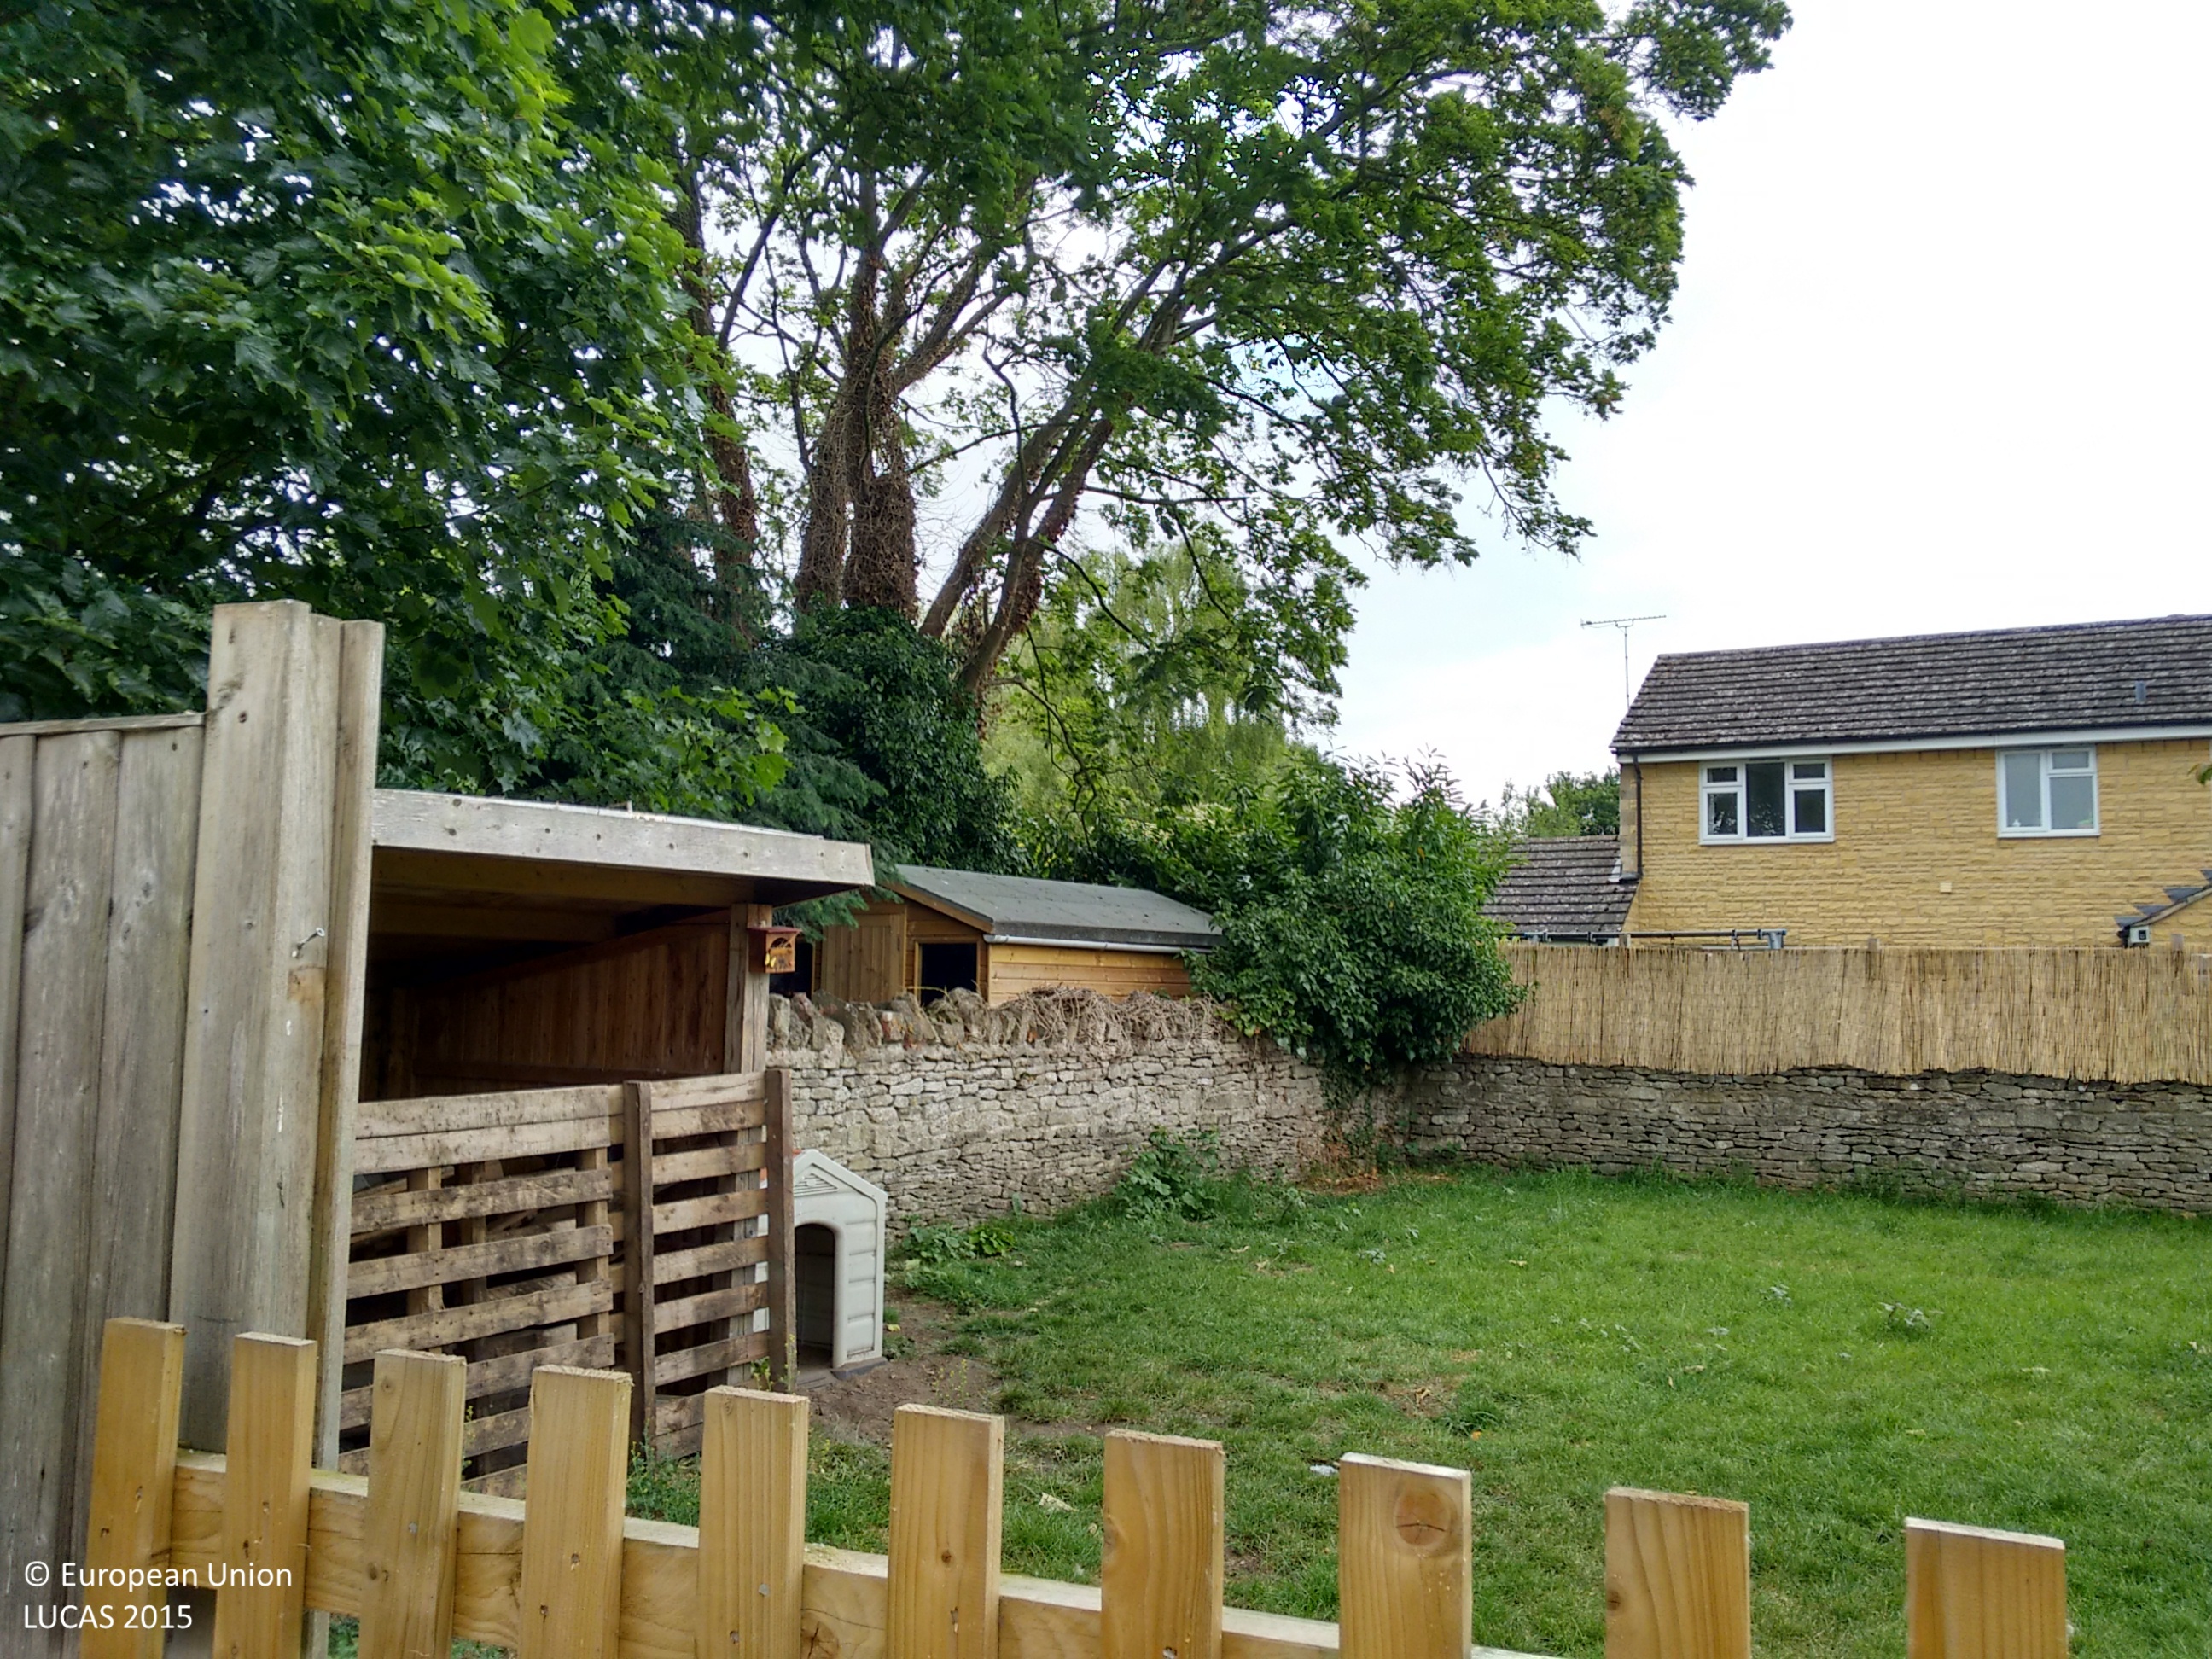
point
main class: Woodland
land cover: Broadleaved woodland
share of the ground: 50 - 75 %
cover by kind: broadleaved forest trees 60 %, herbaceous plants 20 %
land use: Residential
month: June
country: GB
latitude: 51.7168
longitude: -1.5886
